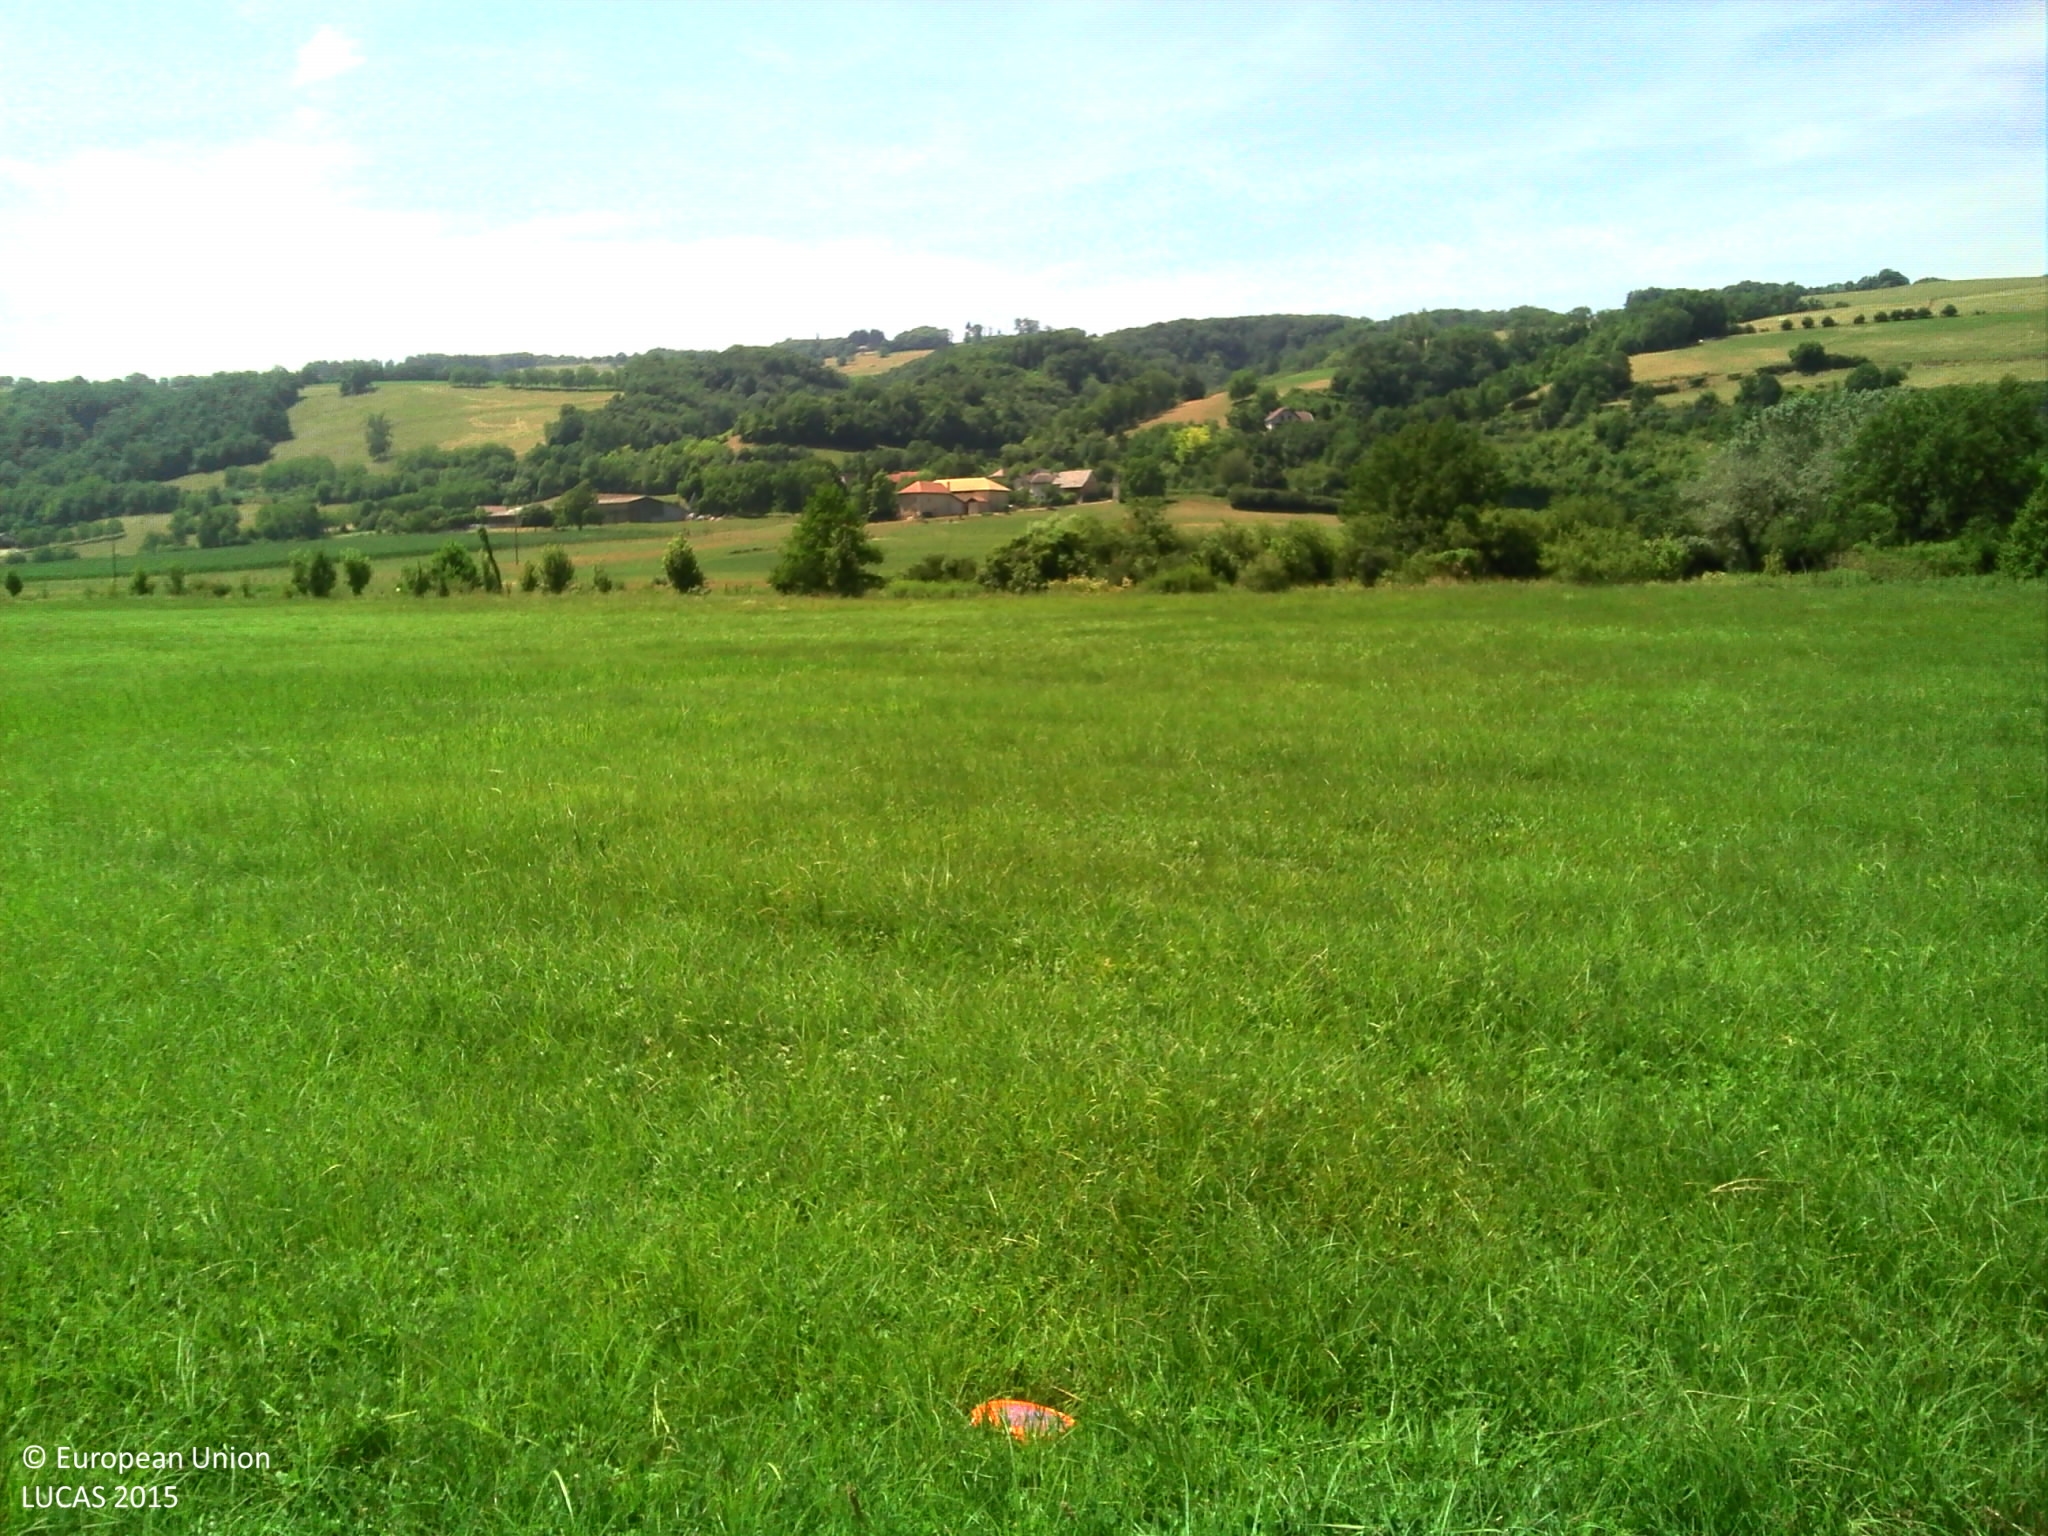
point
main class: Grassland
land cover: Grassland without tree/shrub cover
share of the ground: > 75 %
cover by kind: herbaceous plants 100 %
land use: Agriculture (excluding fallow land and kitchen gardens)
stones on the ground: < 10 %
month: July
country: FR
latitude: 45.4791
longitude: 5.4632
